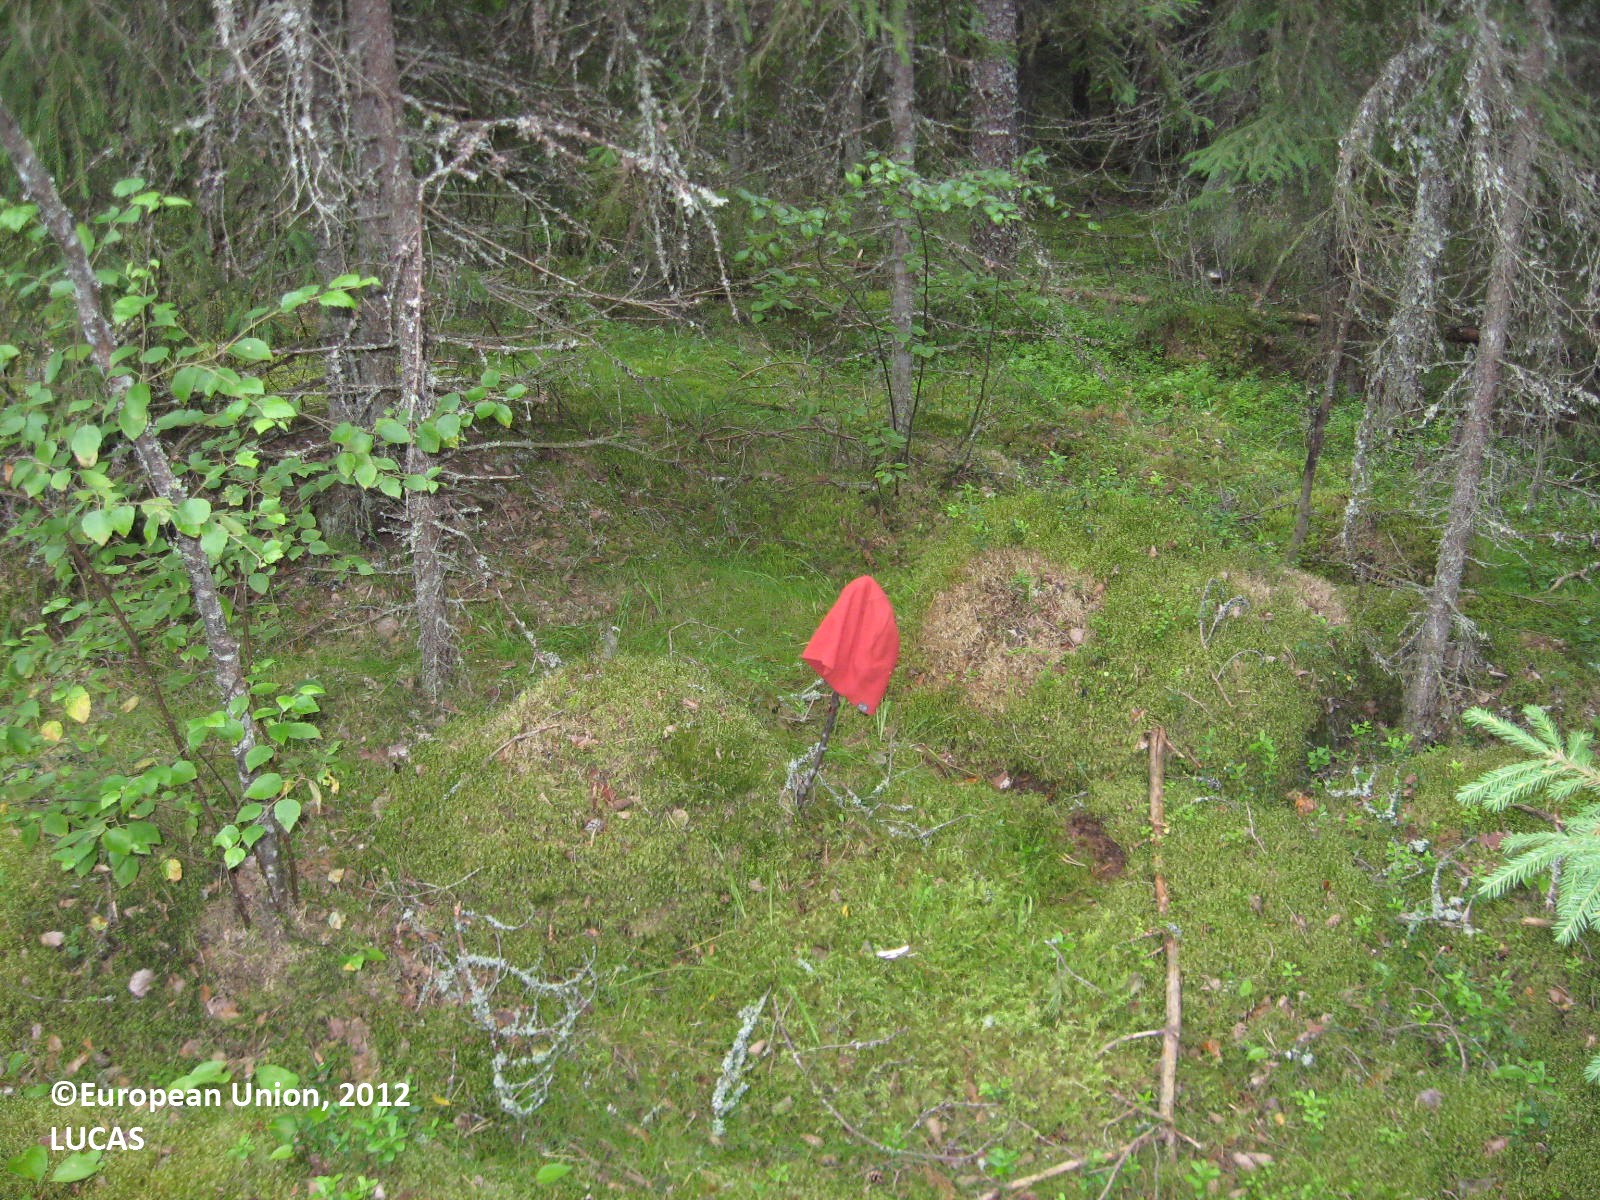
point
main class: Woodland
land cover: Other coniferous woodland
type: boreal forest
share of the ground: > 75 %
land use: Forestry
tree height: > 5 m
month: July
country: FI
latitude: 61.8741
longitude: 21.5528
